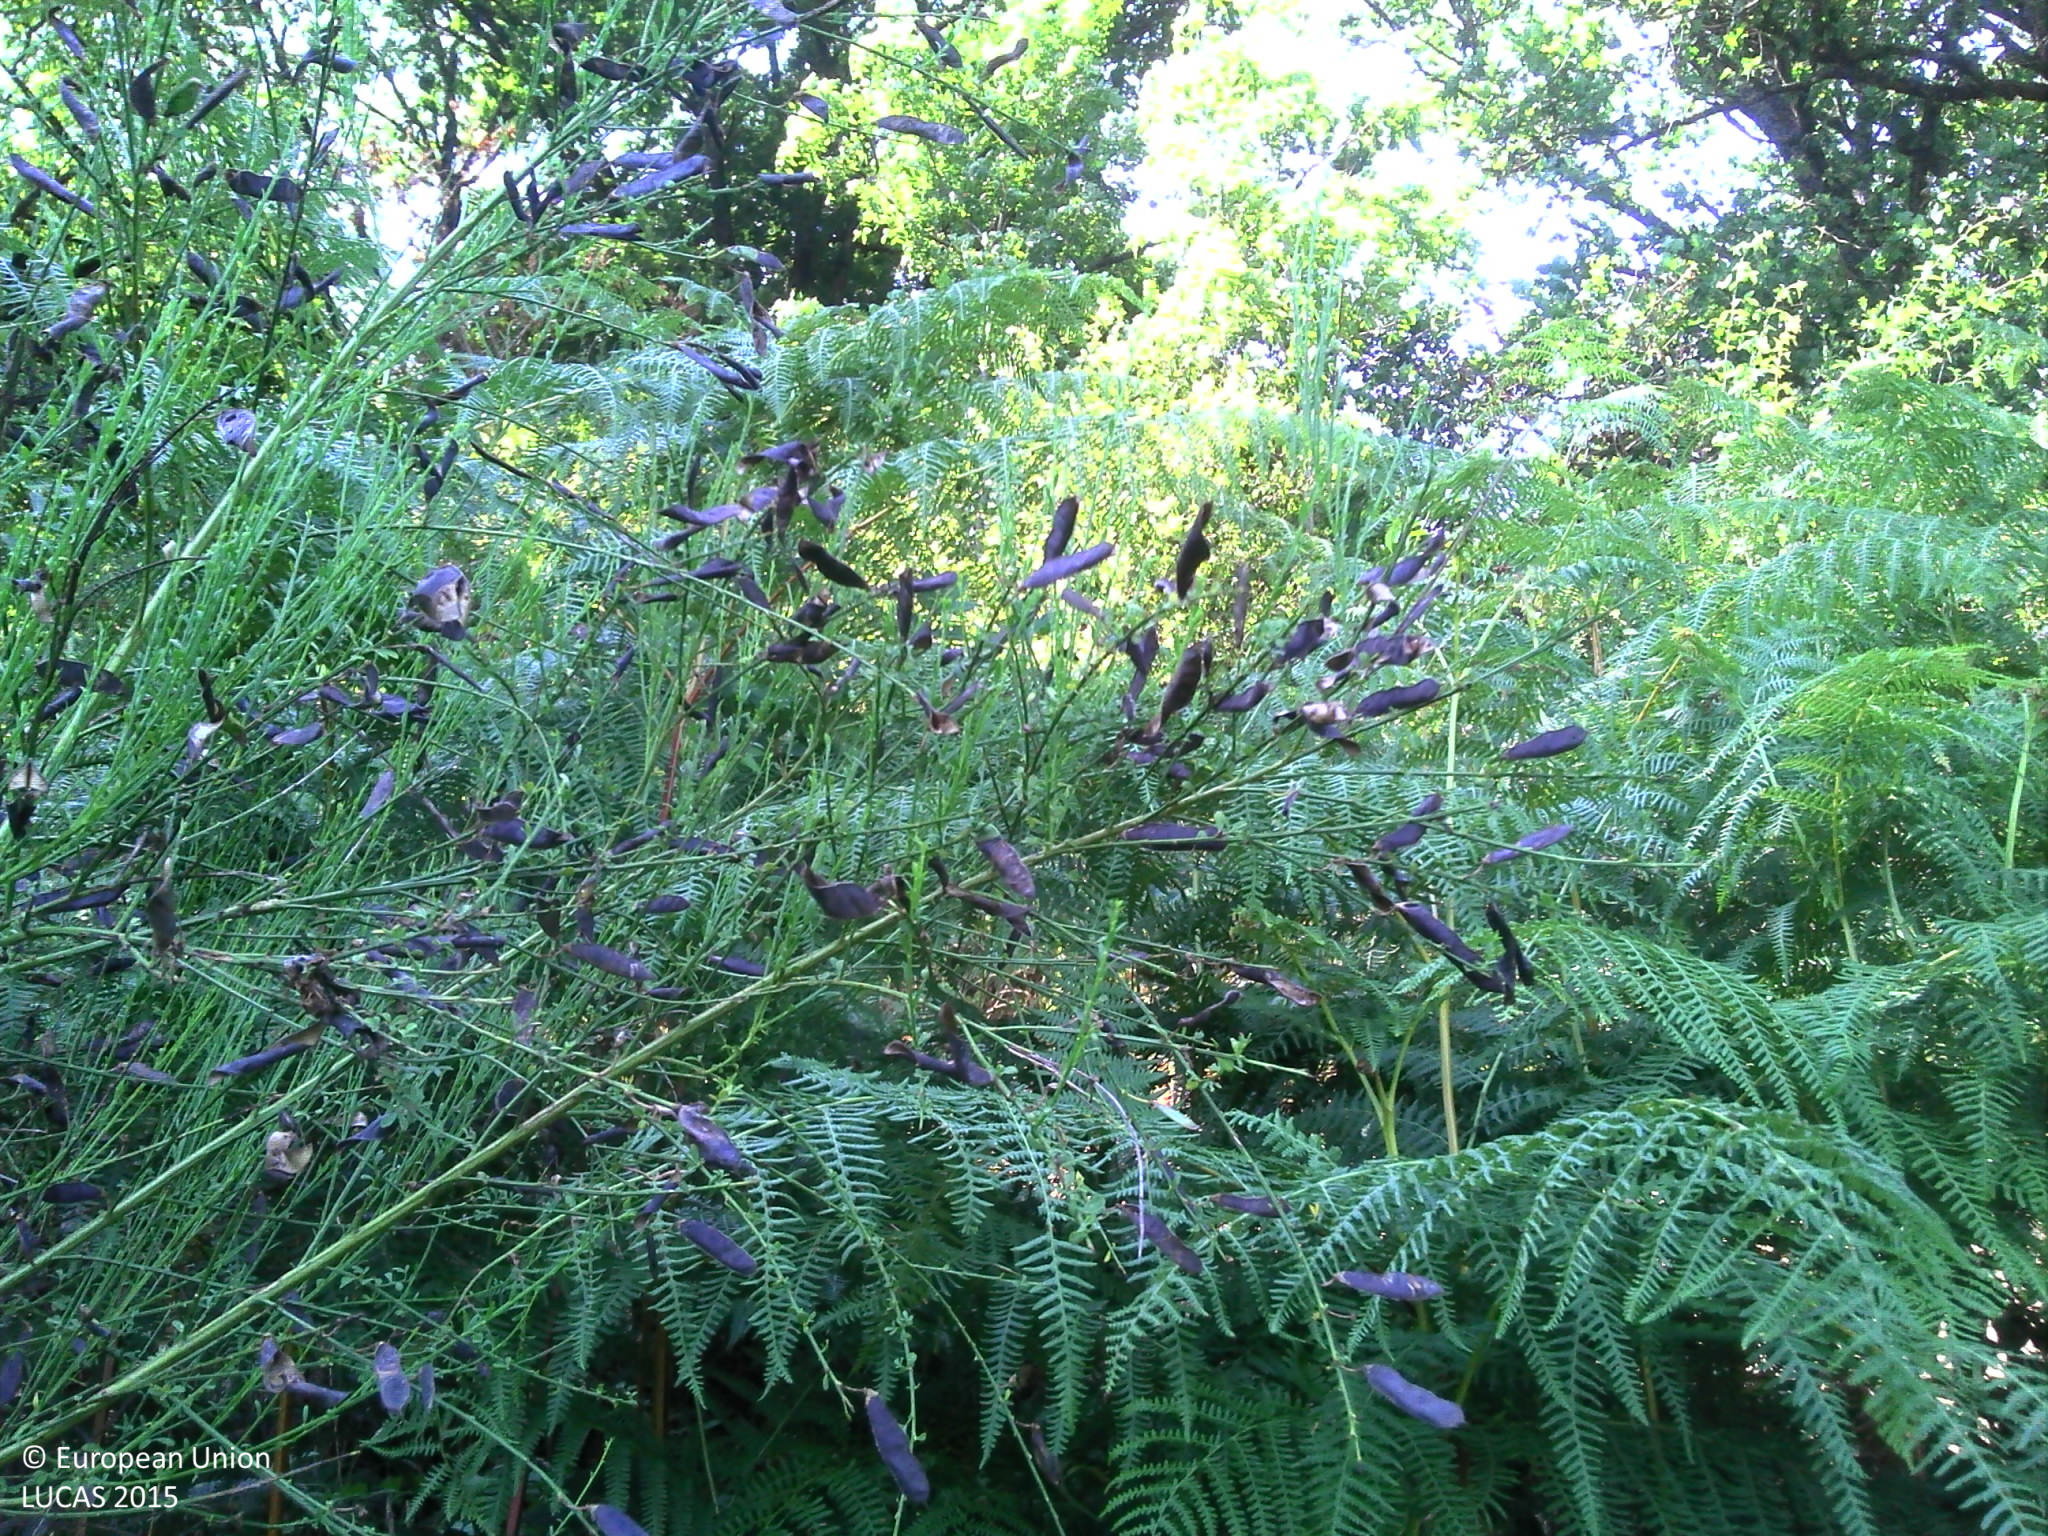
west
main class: Grassland
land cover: Spontaneously vegetated surfaces
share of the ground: > 75 %
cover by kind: herbaceous plants 95 %, shrubs 5 %
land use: Semi-natural and natural areas not in use
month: August
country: FR
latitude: 46.8198
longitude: 4.4299
